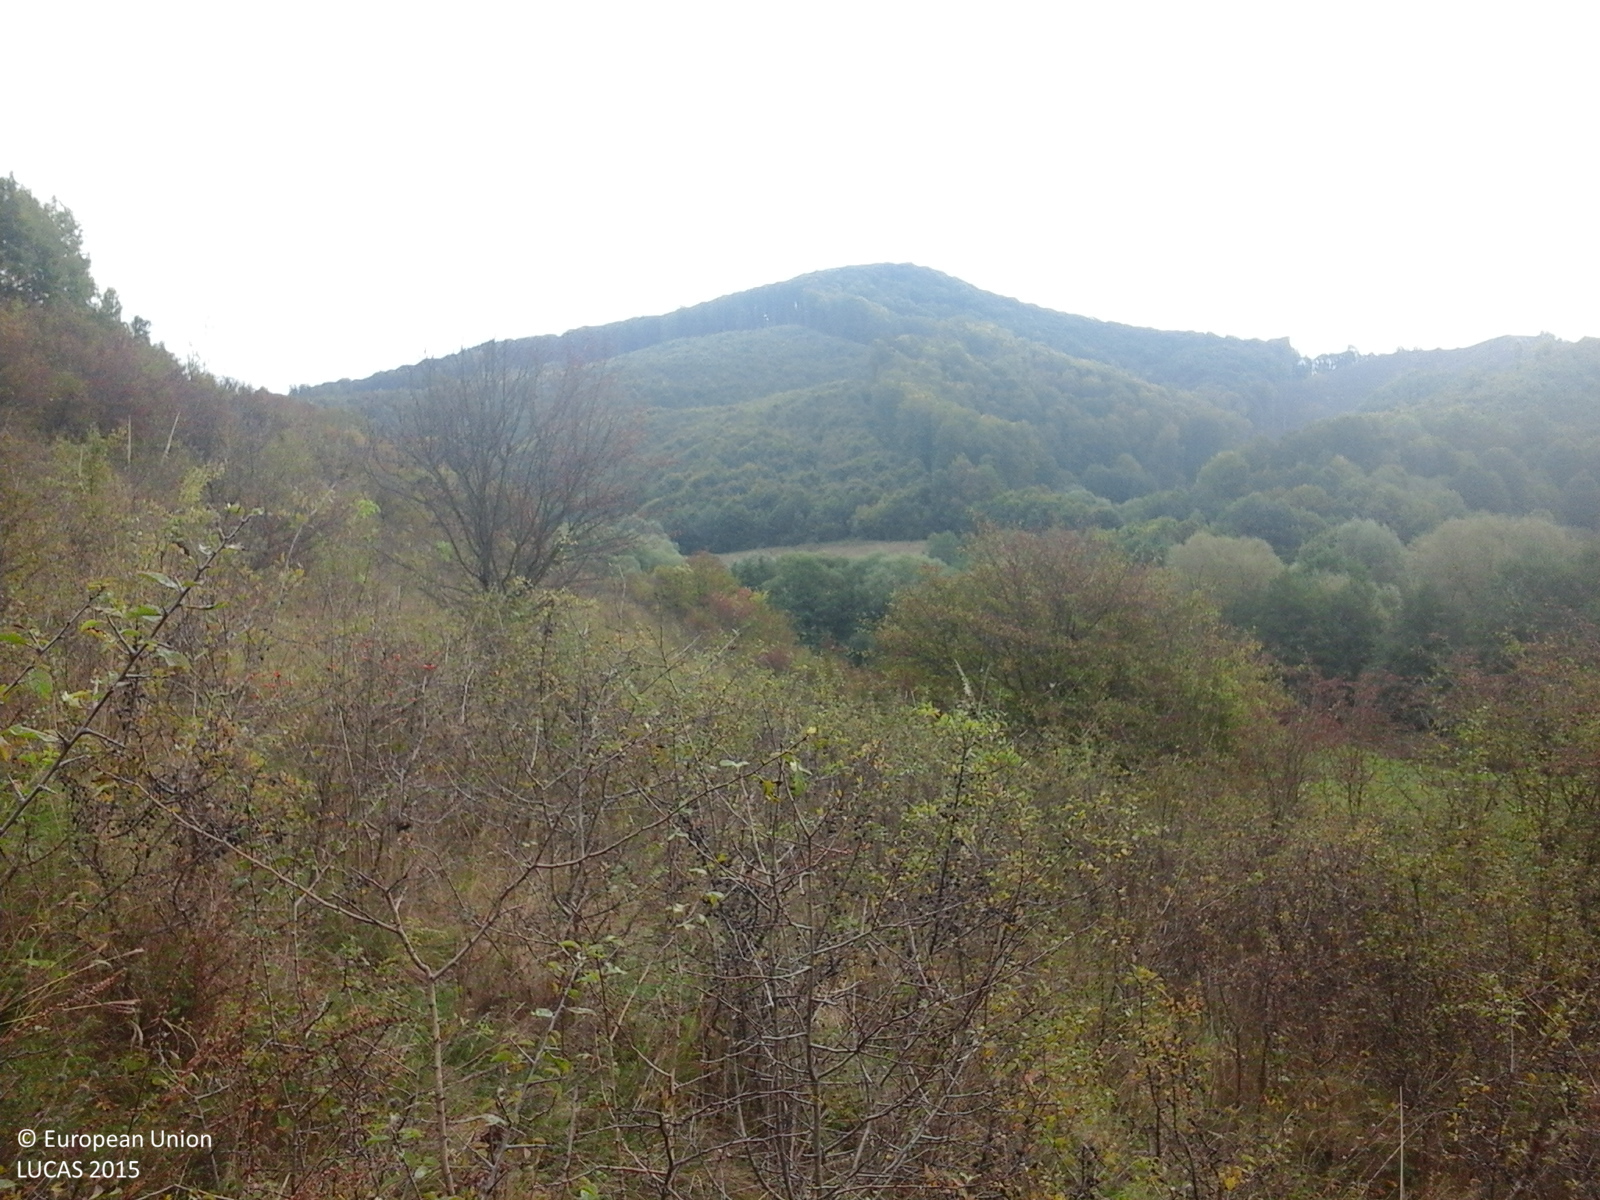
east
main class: Shrubland
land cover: Shrubland without tree cover
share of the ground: > 75 %
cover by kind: shrubs 100 %
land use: Semi-natural and natural areas not in use
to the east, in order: Shrubland without tree cover; Grassland without tree/shrub cover; Ditches and canals; Broadleaved woodland; Grassland without tree/shrub cover
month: October
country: RO
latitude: 46.4957
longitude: 24.9896
